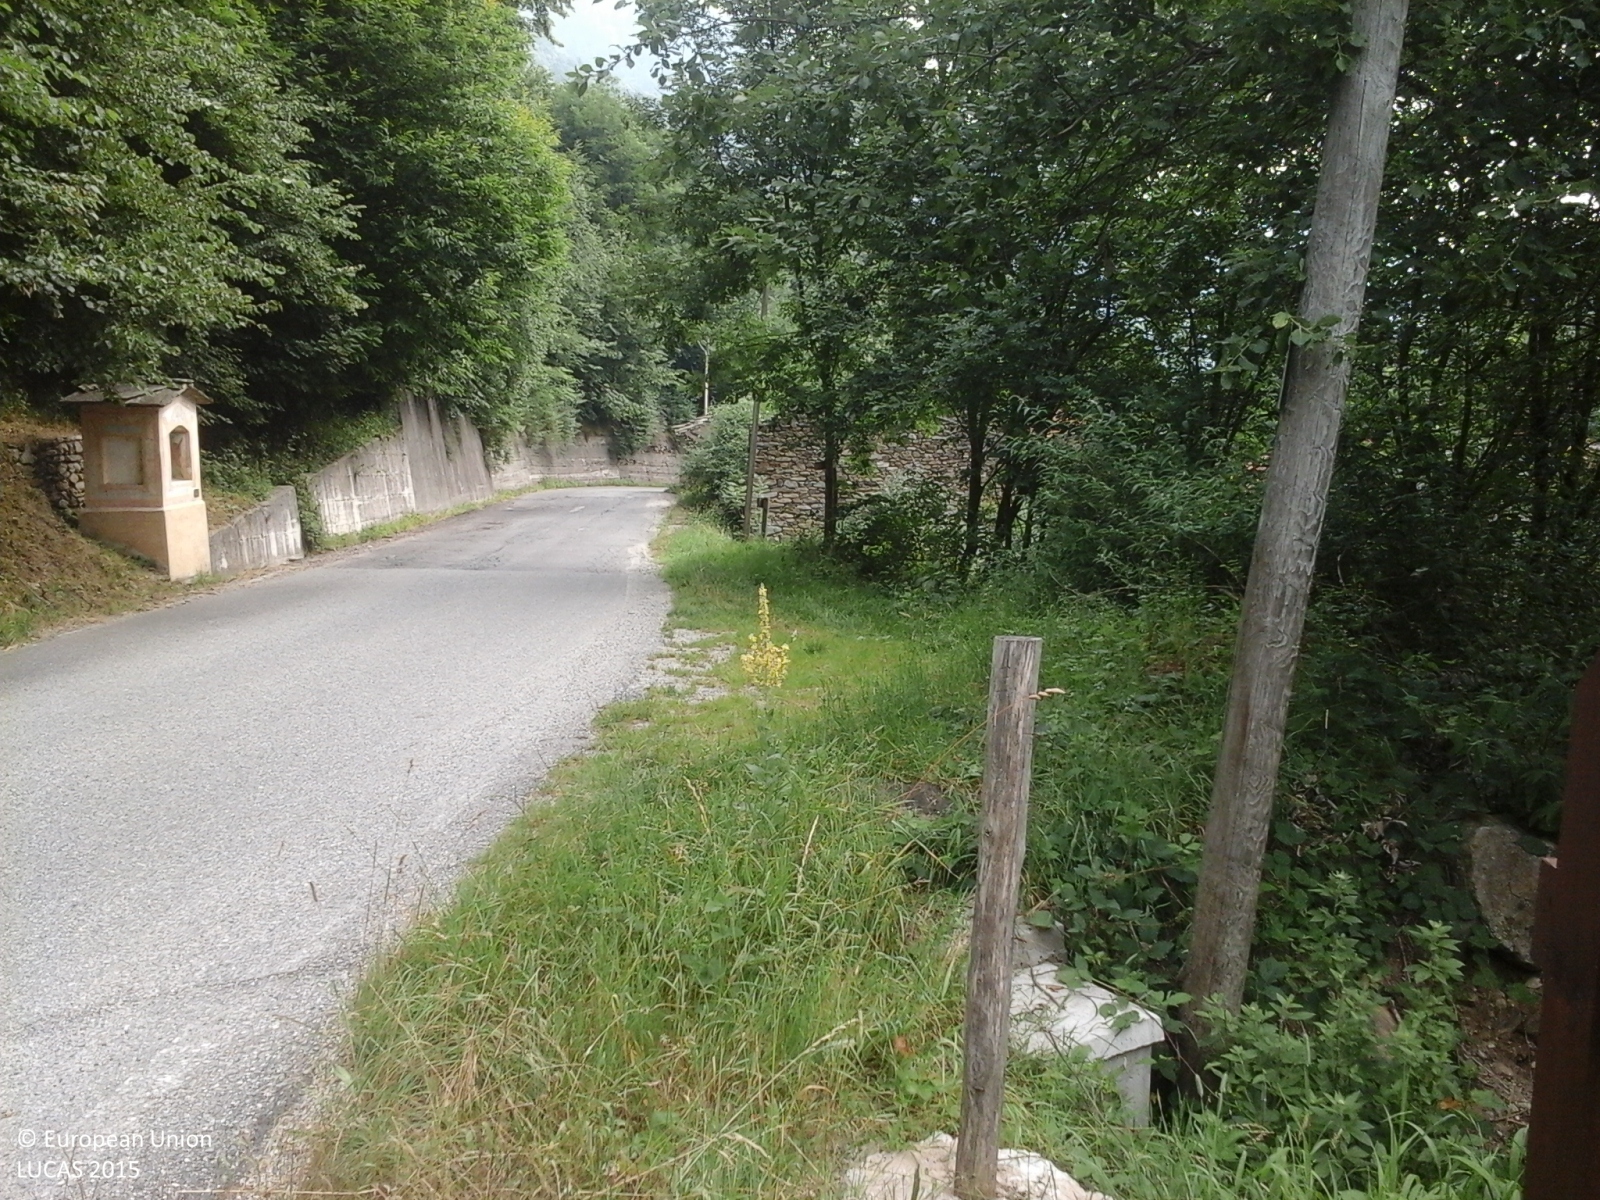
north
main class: Woodland
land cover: Broadleaved woodland
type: mesophytic deciduous forest
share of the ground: > 75 %
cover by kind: broadleaved forest trees 100 %
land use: Forestry
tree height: > 5 m
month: July
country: IT
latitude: 45.0358
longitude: 7.2501
